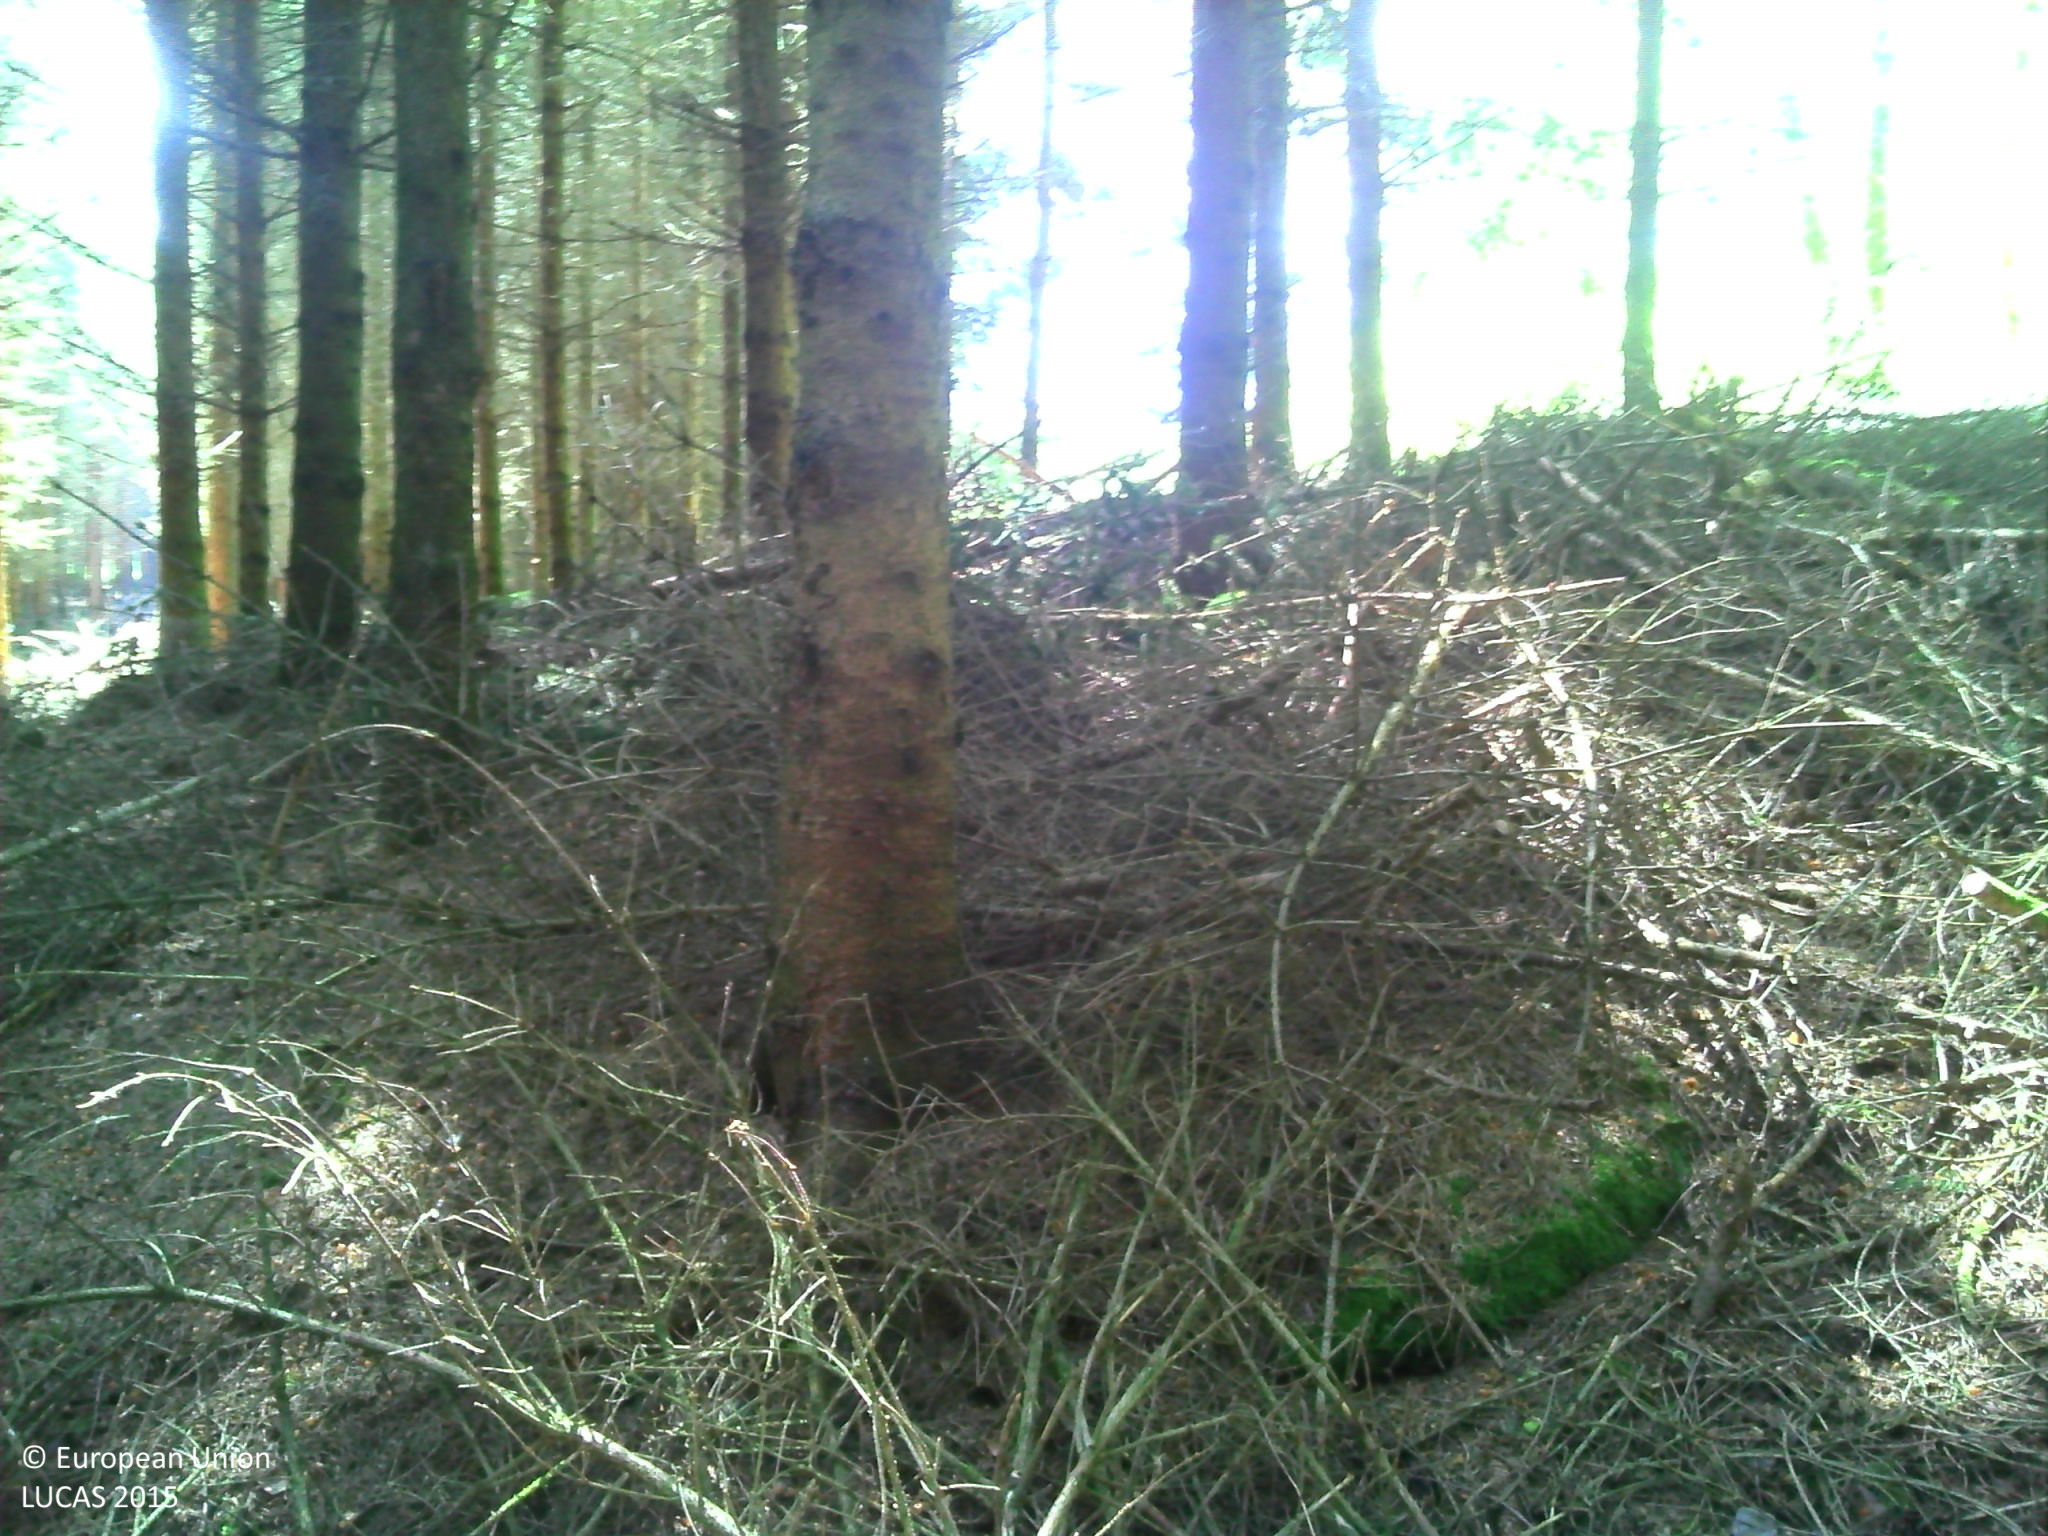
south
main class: Woodland
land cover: Spruce dominated coniferous woodland
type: exotic forest
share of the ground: > 75 %
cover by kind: coniferous forest trees 90 %, broadleaved forest trees 5 %, lichens and mosses 5 %
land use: Forestry
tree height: > 5 m
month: May
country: LU
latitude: 50.1306
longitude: 5.9562
